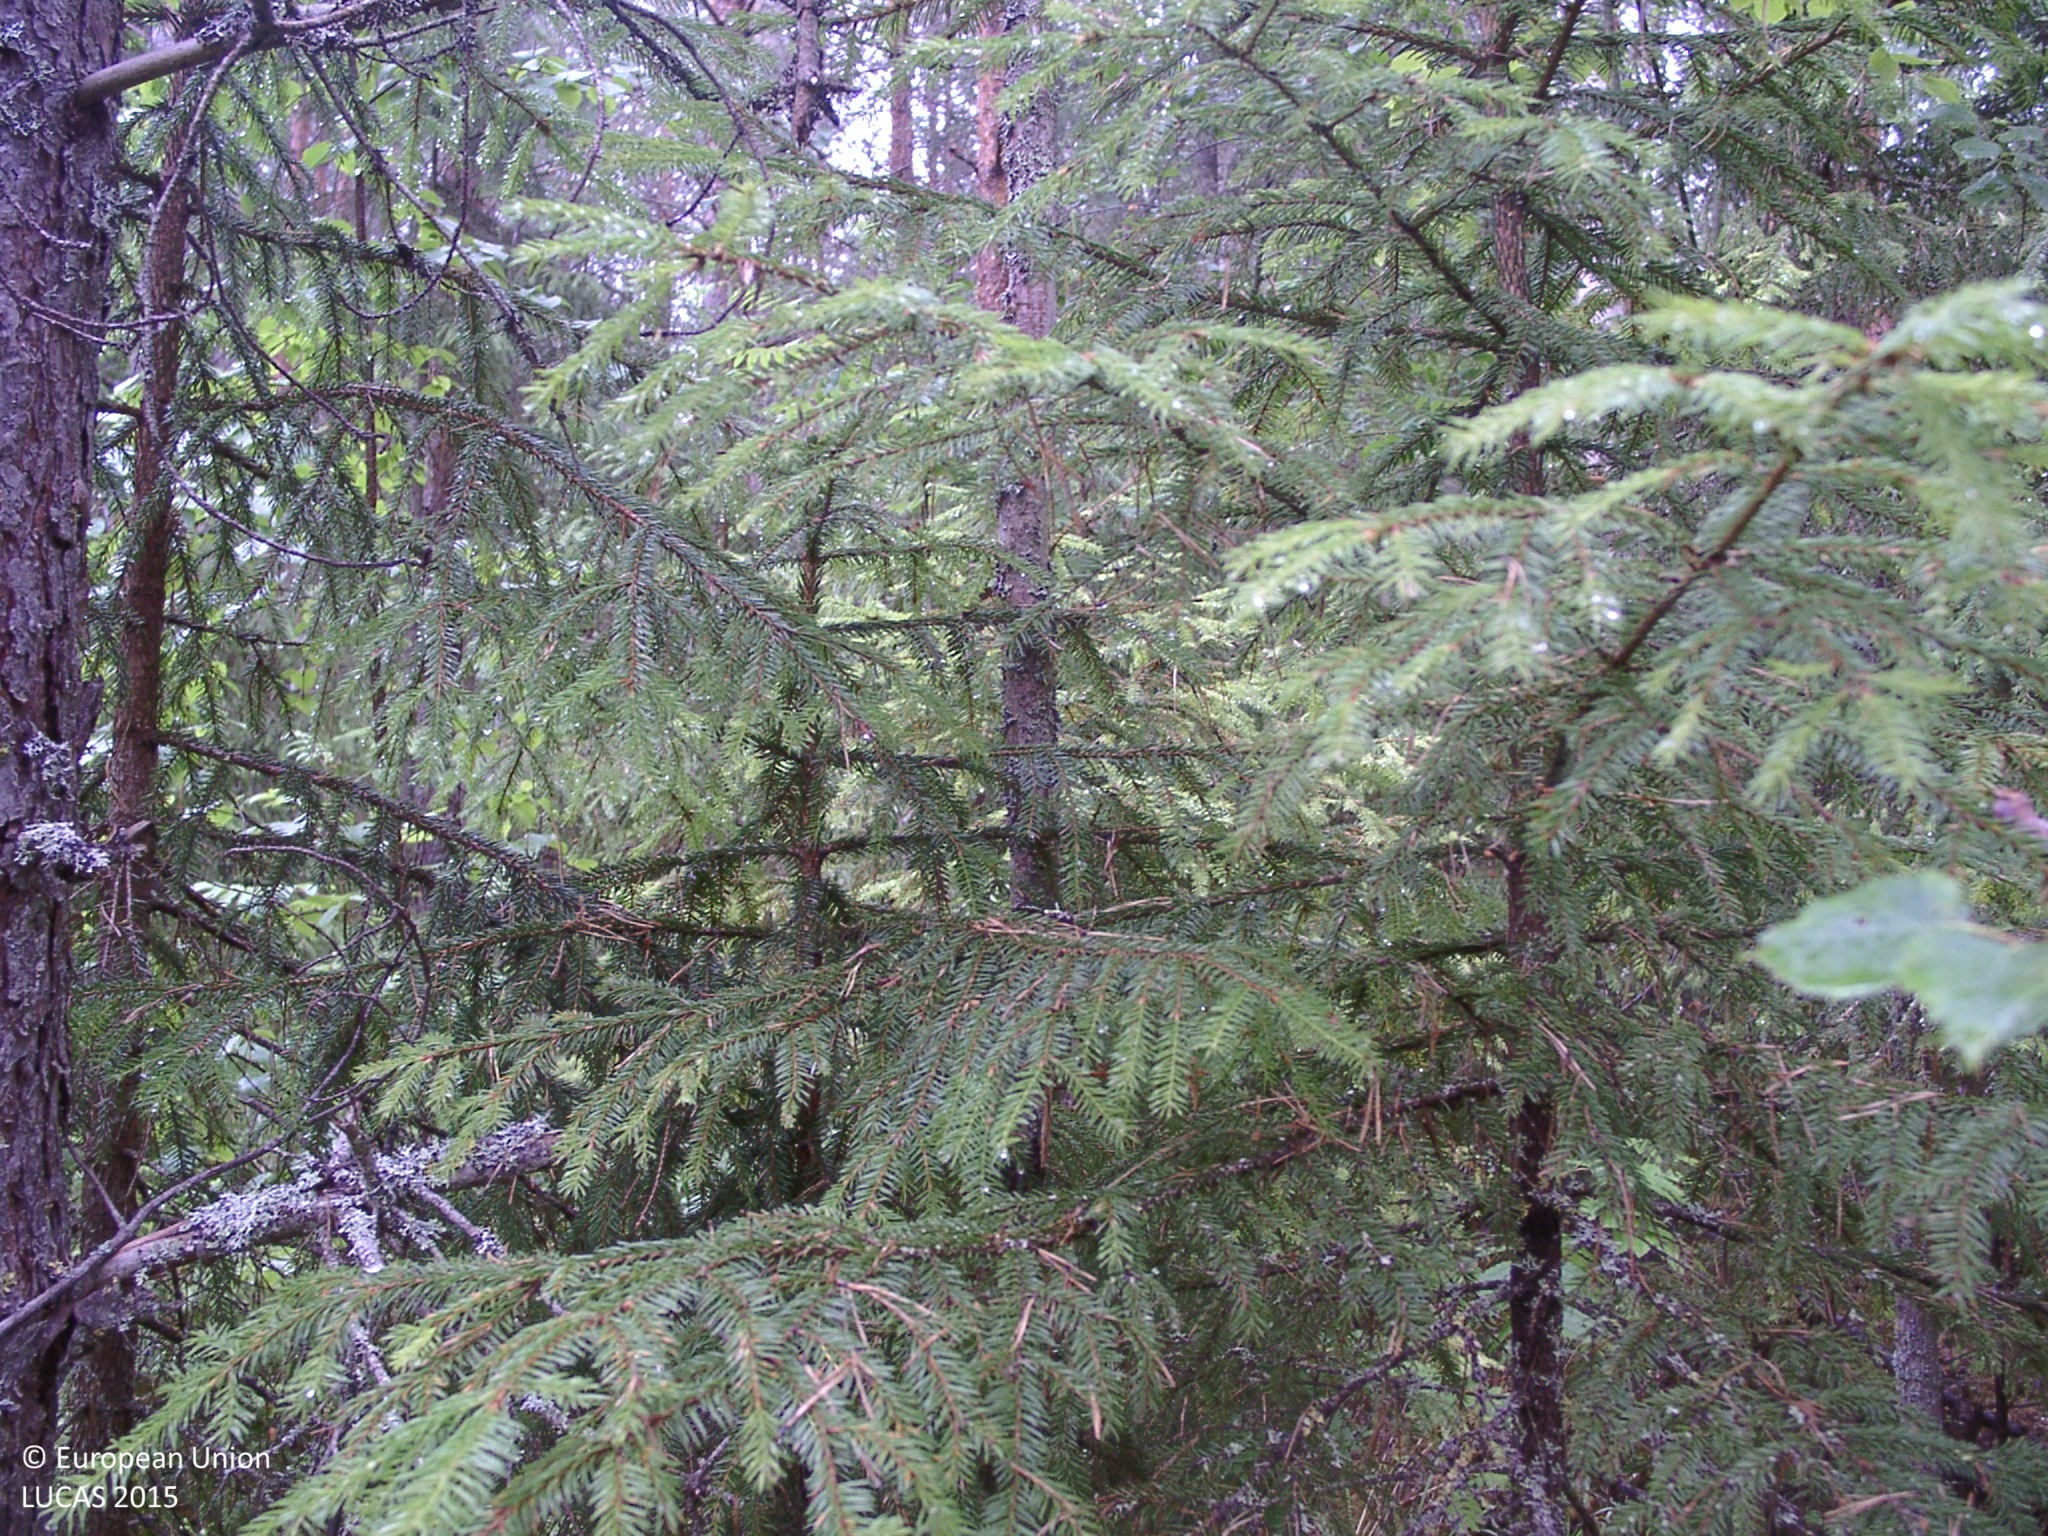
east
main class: Woodland
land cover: Other mixed woodland
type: boreal forest
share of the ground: 50 - 75 %
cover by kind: coniferous forest trees 50 %, broadleaved forest trees 35 %, shrubs 5 %, herbaceous plants 5 %, lichens and mosses 5 %
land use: Semi-natural and natural areas not in use
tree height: > 5 m
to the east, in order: Other mixed woodland; Grass margins; Spruce dominated mixed woodland; Spruce dominated coniferous woodland; Spruce dominated mixed woodland; Grassland with sparse tree/shrub cover; Paved roads, cycling and walking lanes
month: July
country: FI
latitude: 62.1075
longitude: 25.2274
